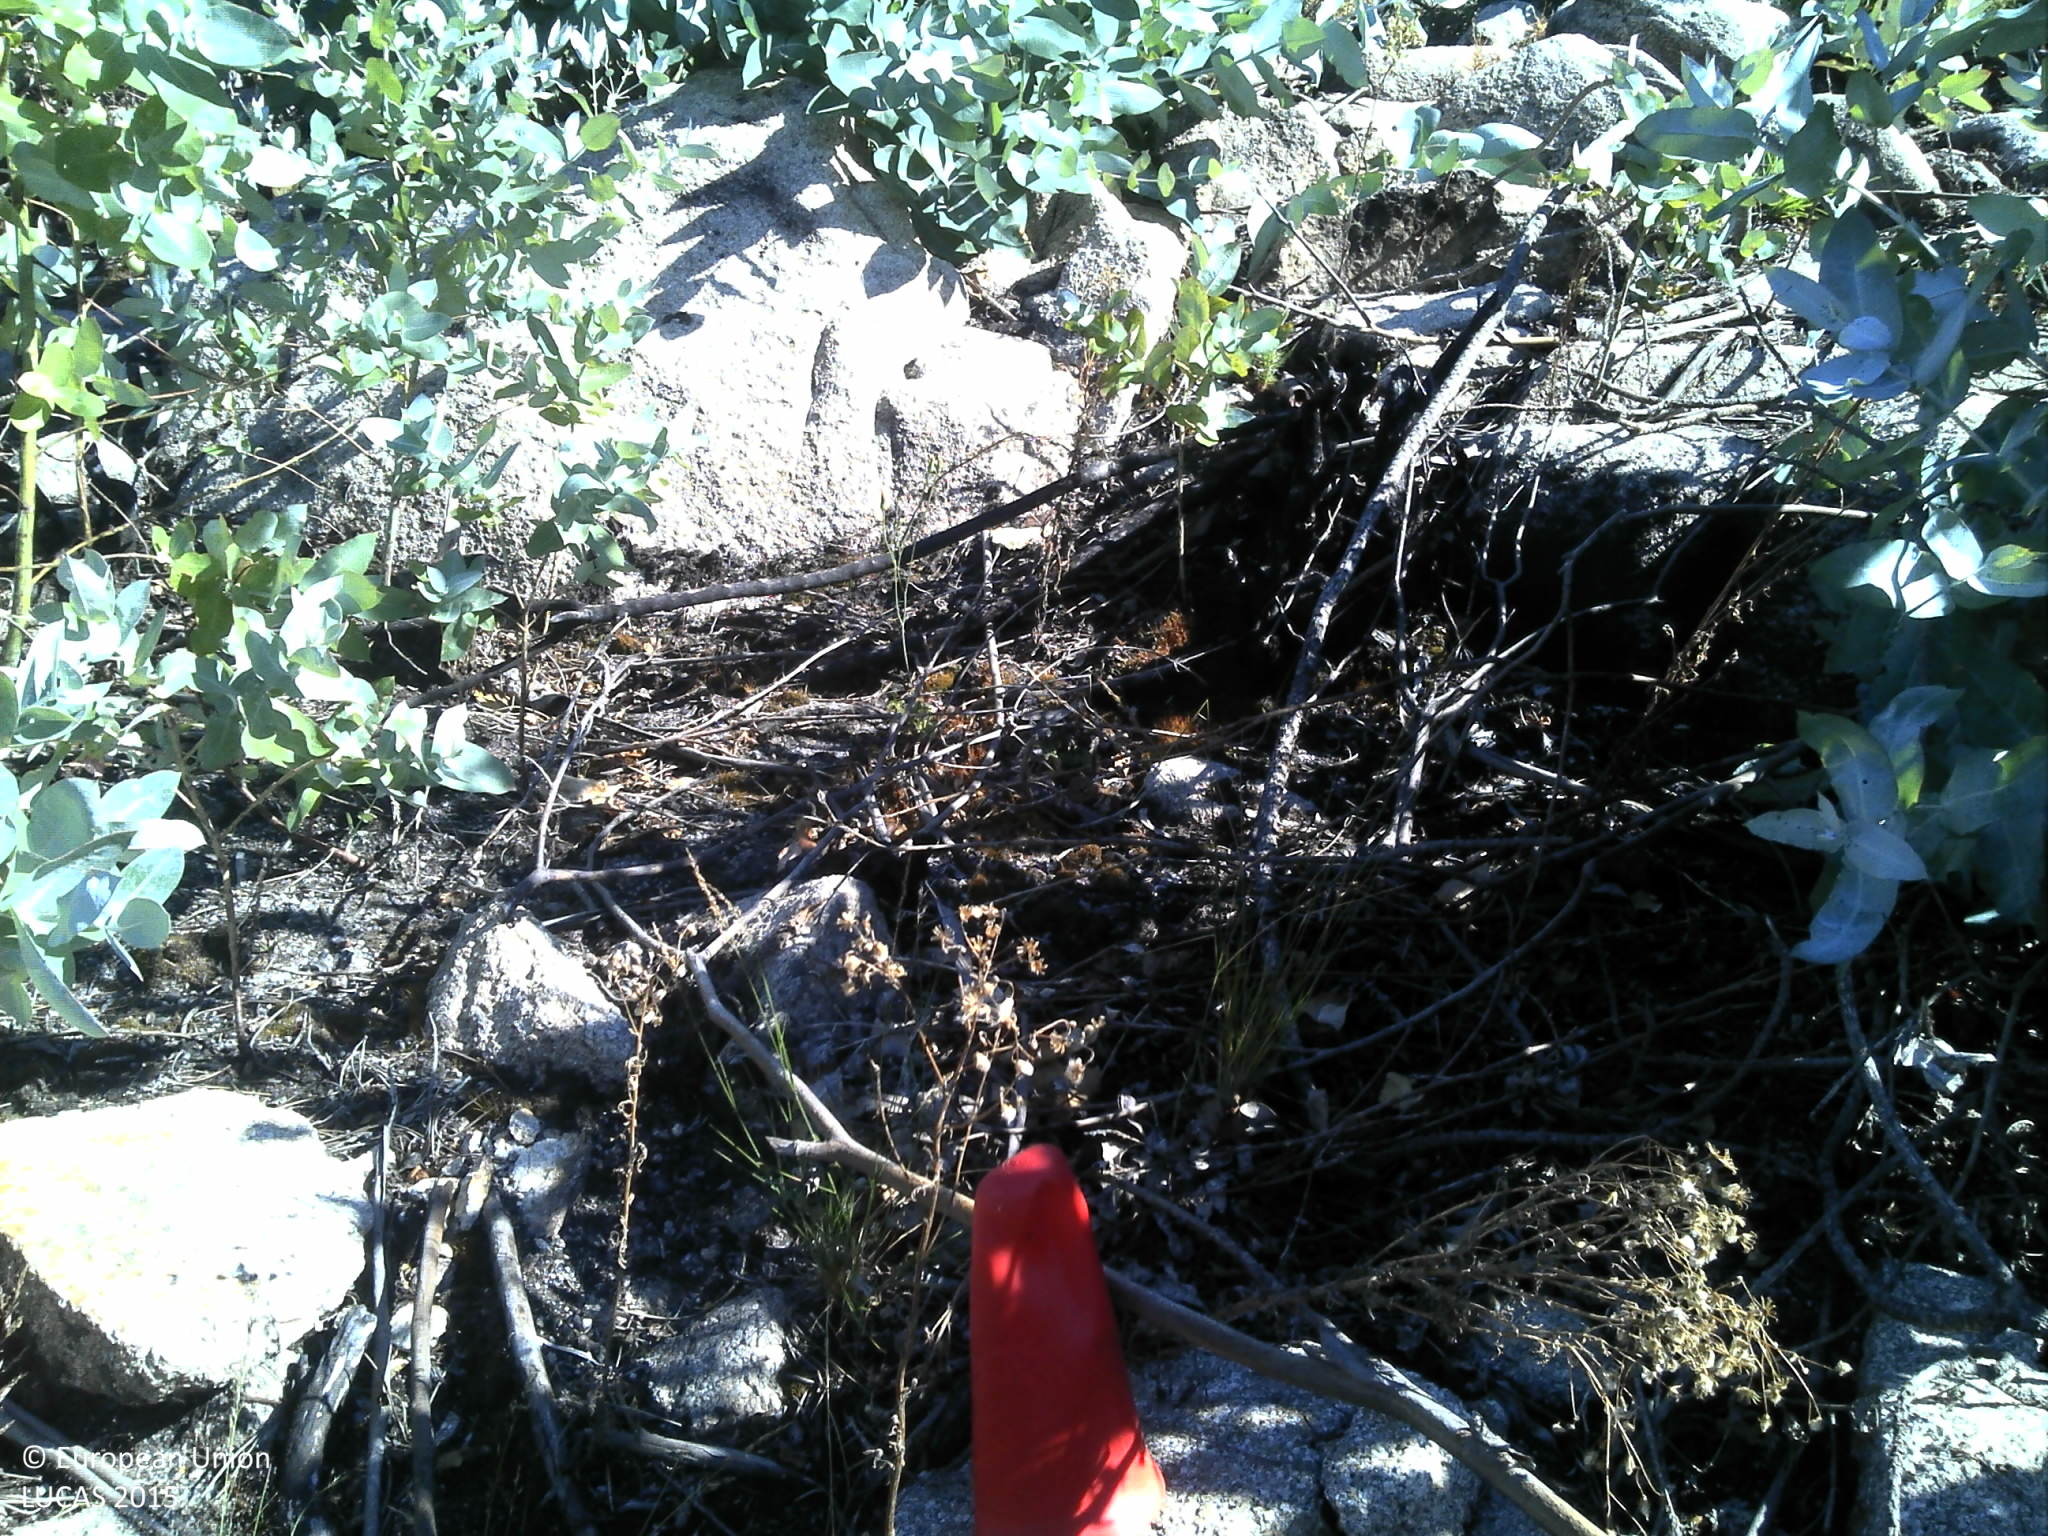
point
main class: Woodland
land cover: Broadleaved woodland
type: exotic forest
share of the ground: 25 - 50 %
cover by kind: broadleaved forest trees 50 %, unconsolidated bare surface 25 %, consolidated bare surface 20 %, shrubs 5 %
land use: Forestry
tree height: < 5 m
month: June
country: PT
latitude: 40.5919
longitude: -8.2461
